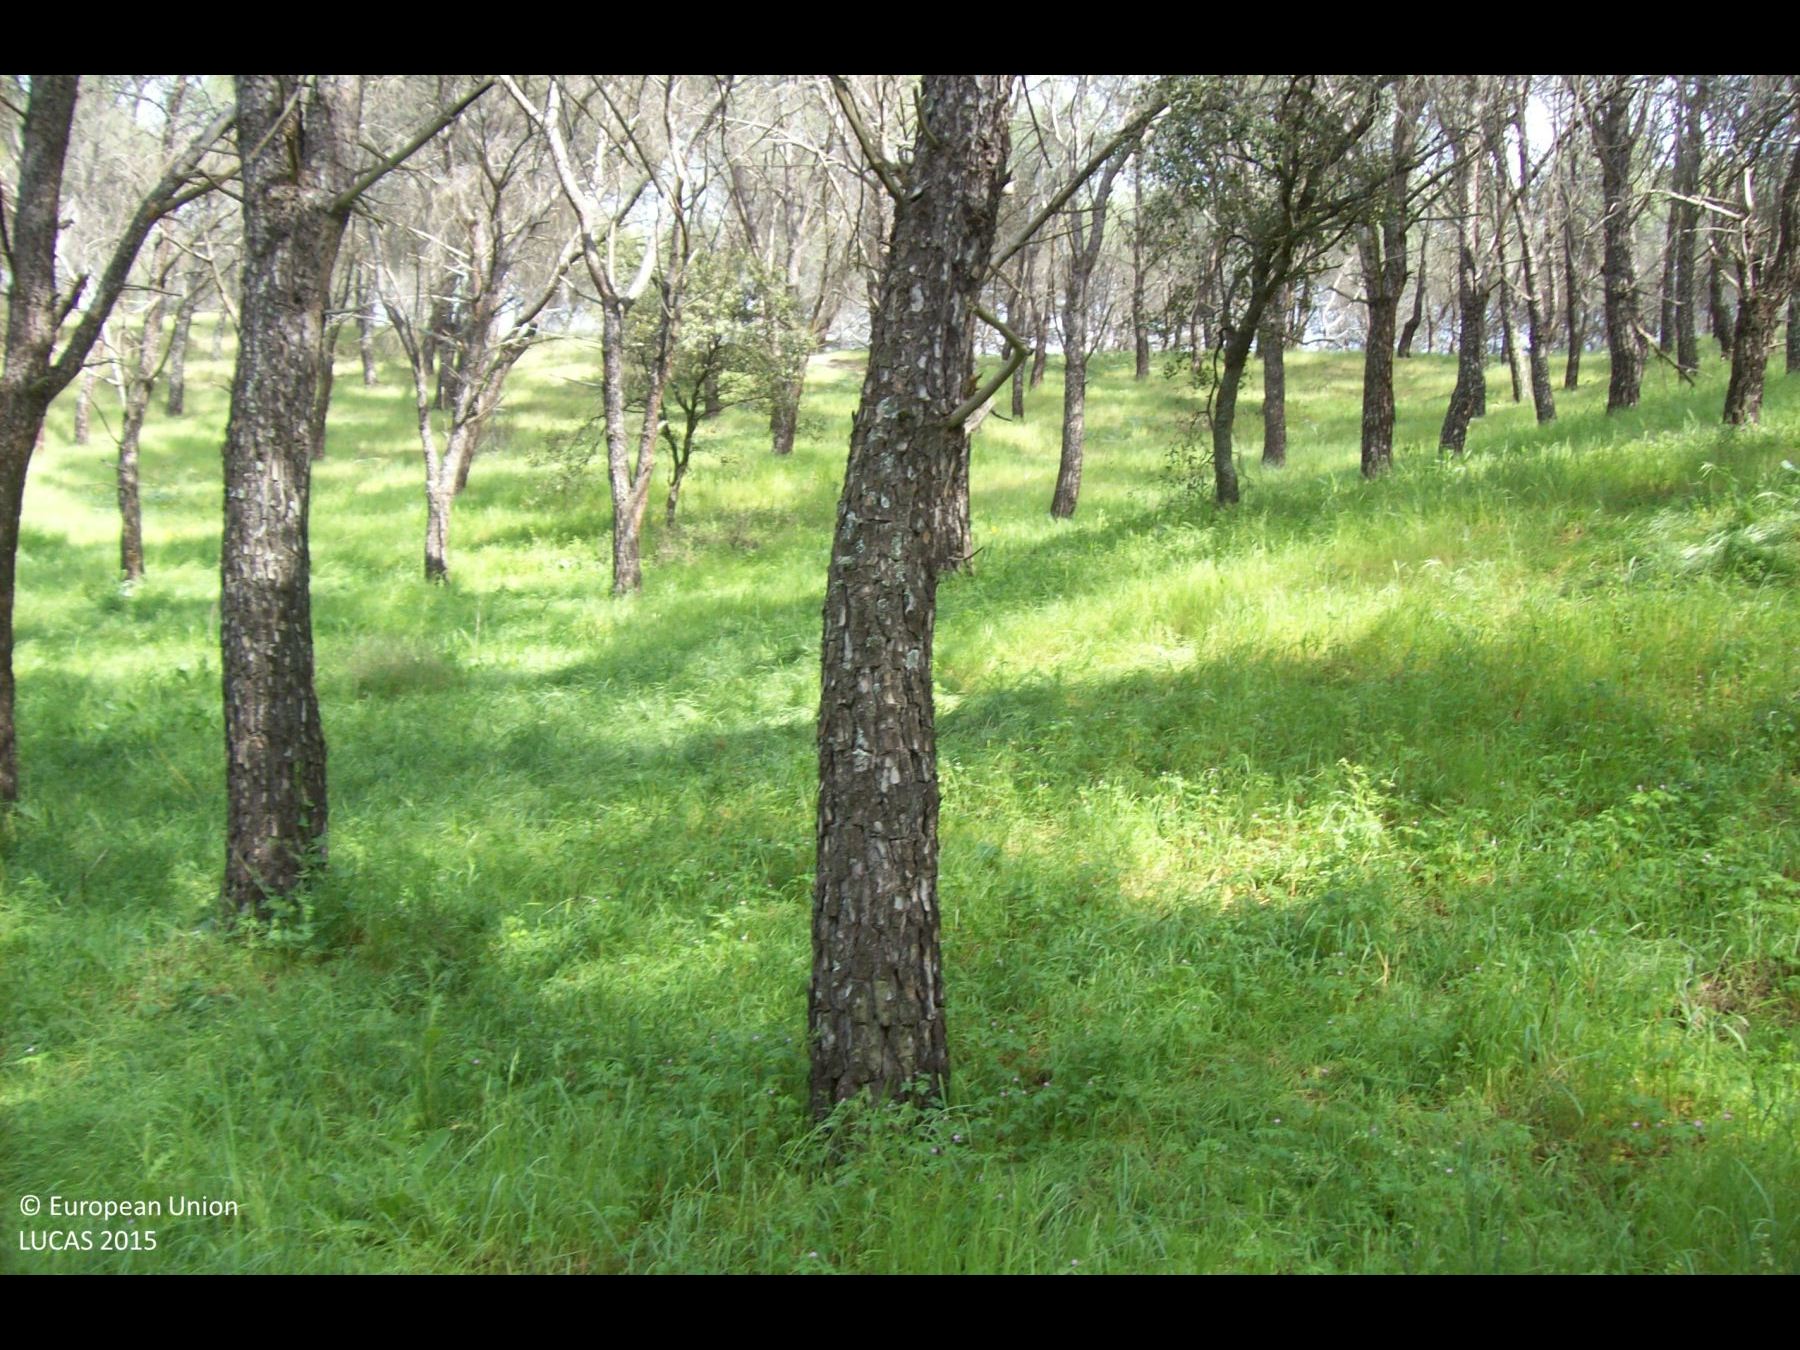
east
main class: Woodland
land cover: Pine dominated coniferous woodland
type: coniferous forest of the mediterranean region
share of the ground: > 75 %
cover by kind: coniferous forest trees 90 %, herbaceous plants 10 %
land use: Amenities, museums, leisure
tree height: > 5 m
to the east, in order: Pine dominated coniferous woodland; Electric lines; Pine dominated coniferous woodland; Tracks; Shrubland without tree cover; Tracks; Shrubland without tree cover; Tracks; Shrubland without tree cover; Tracks; Shrubland without tree cover; Paved roads, cycling and walking lanes; Shrubland without tree cover; Single bushes/trees; Shrubland without tree cover
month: April
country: ES
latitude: 40.5192
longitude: -3.7668
